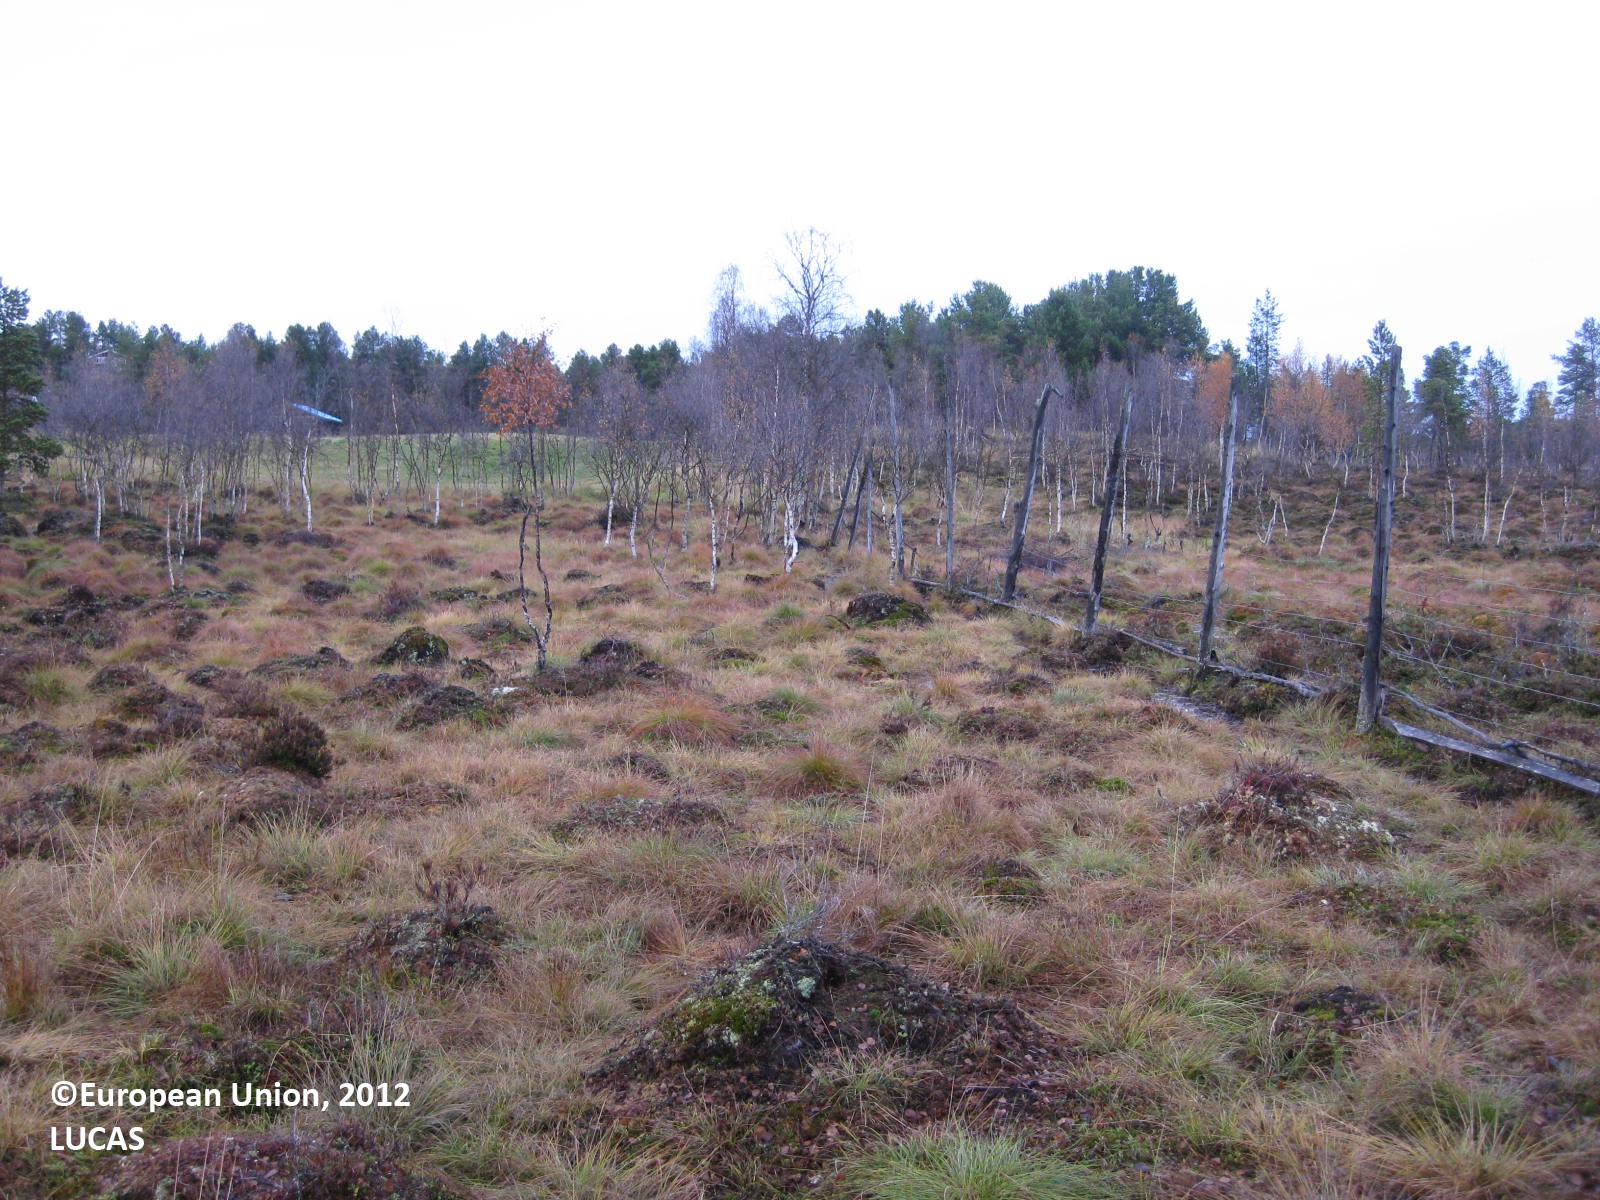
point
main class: Woodland
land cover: Broadleaved woodland
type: boreal forest
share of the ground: 25 - 50 %
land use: Agriculture (excluding fallow land and kitchen gardens)
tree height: > 5 m
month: September
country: FI
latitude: 68.4397
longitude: 24.0308
